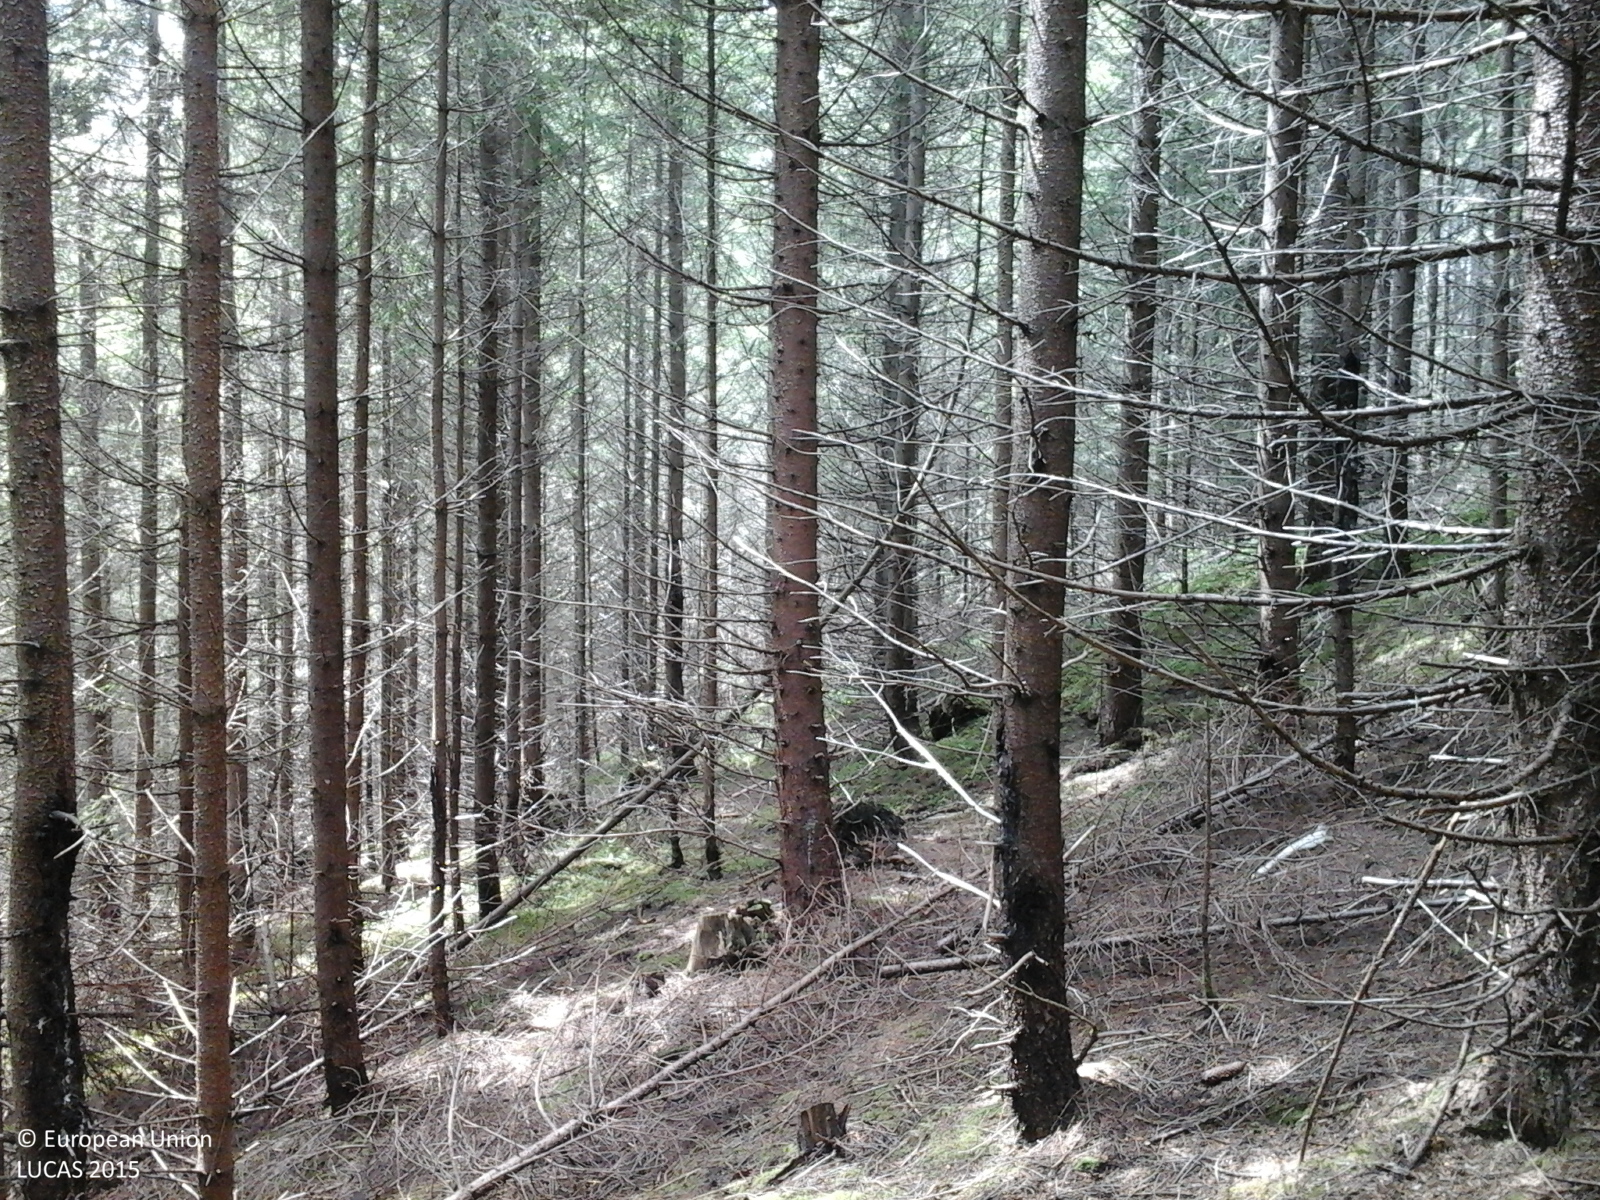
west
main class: Woodland
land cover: Spruce dominated coniferous woodland
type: alpine coniferous forest
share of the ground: > 75 %
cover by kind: coniferous forest trees 100 %
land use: Forestry
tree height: > 5 m
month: June
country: RO
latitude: 47.6556
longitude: 25.3316
